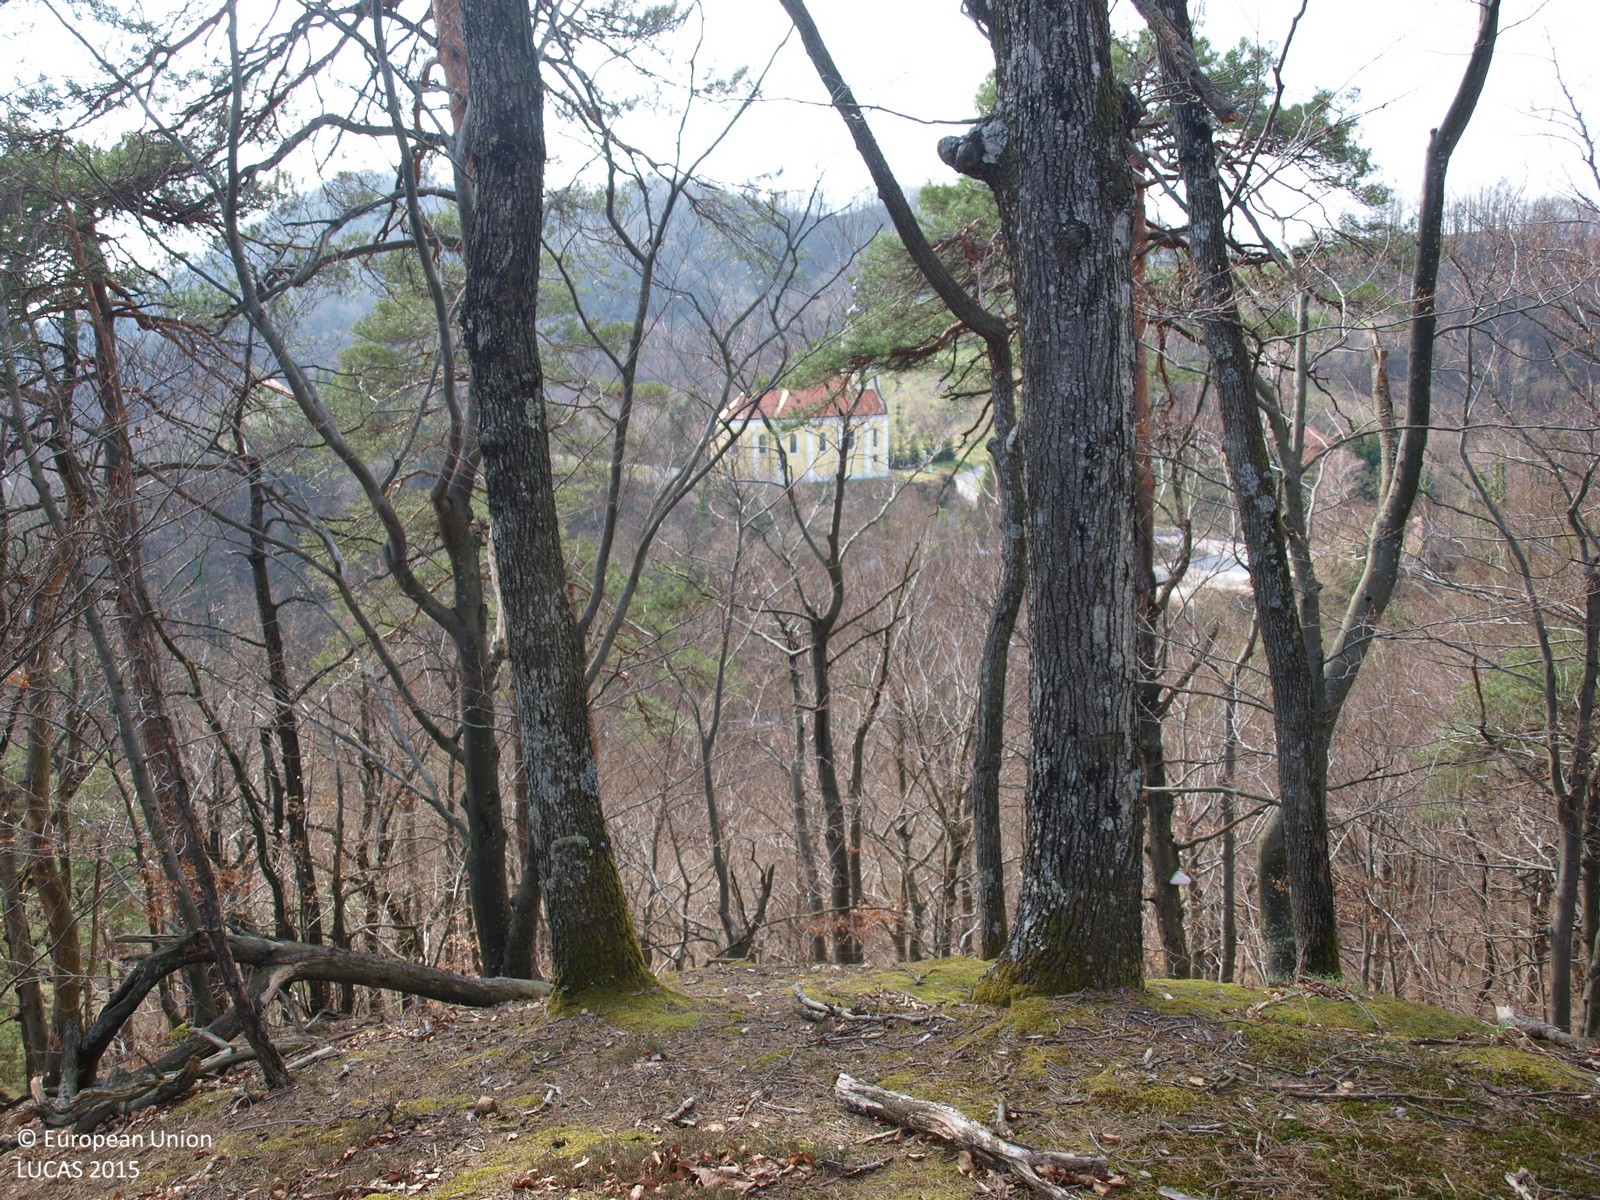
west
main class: Woodland
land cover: Broadleaved woodland
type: mesophytic deciduous forest
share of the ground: > 75 %
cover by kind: broadleaved forest trees 90 %, coniferous forest trees 10 %
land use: Forestry
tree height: > 5 m
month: March
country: HR
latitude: 46.2935
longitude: 15.9575
